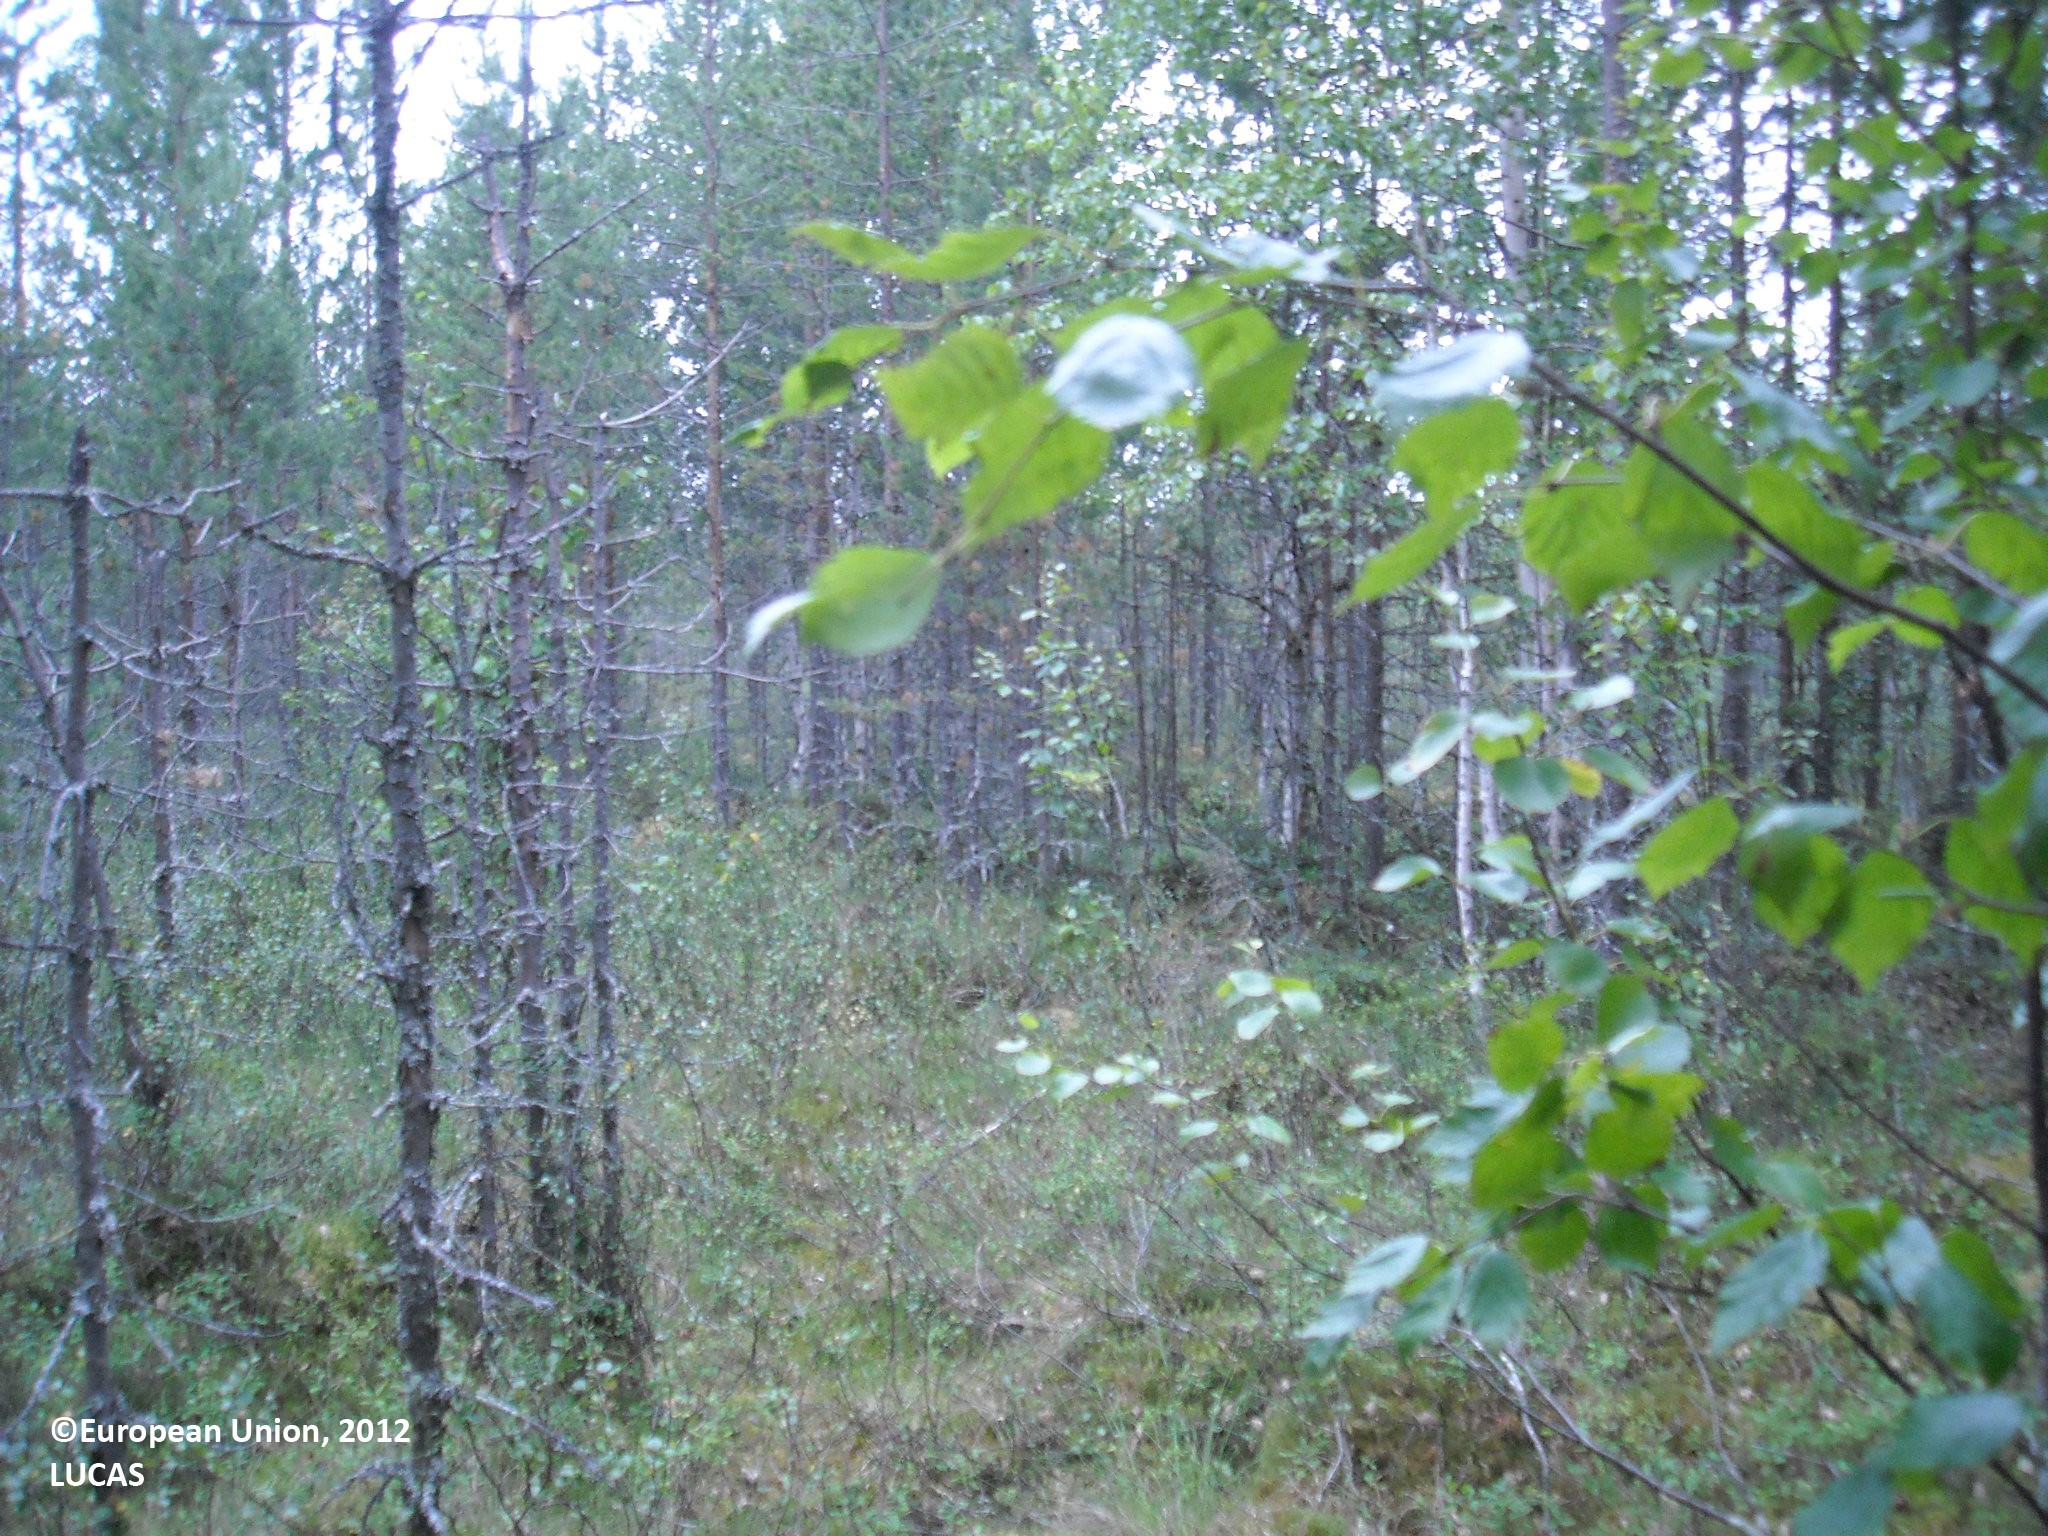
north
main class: Woodland
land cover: Pine dominated mixed woodland
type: mire and swamp forests
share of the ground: > 75 %
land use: Forestry
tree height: > 5 m
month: July
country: FI
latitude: 64.9179
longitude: 26.8415
